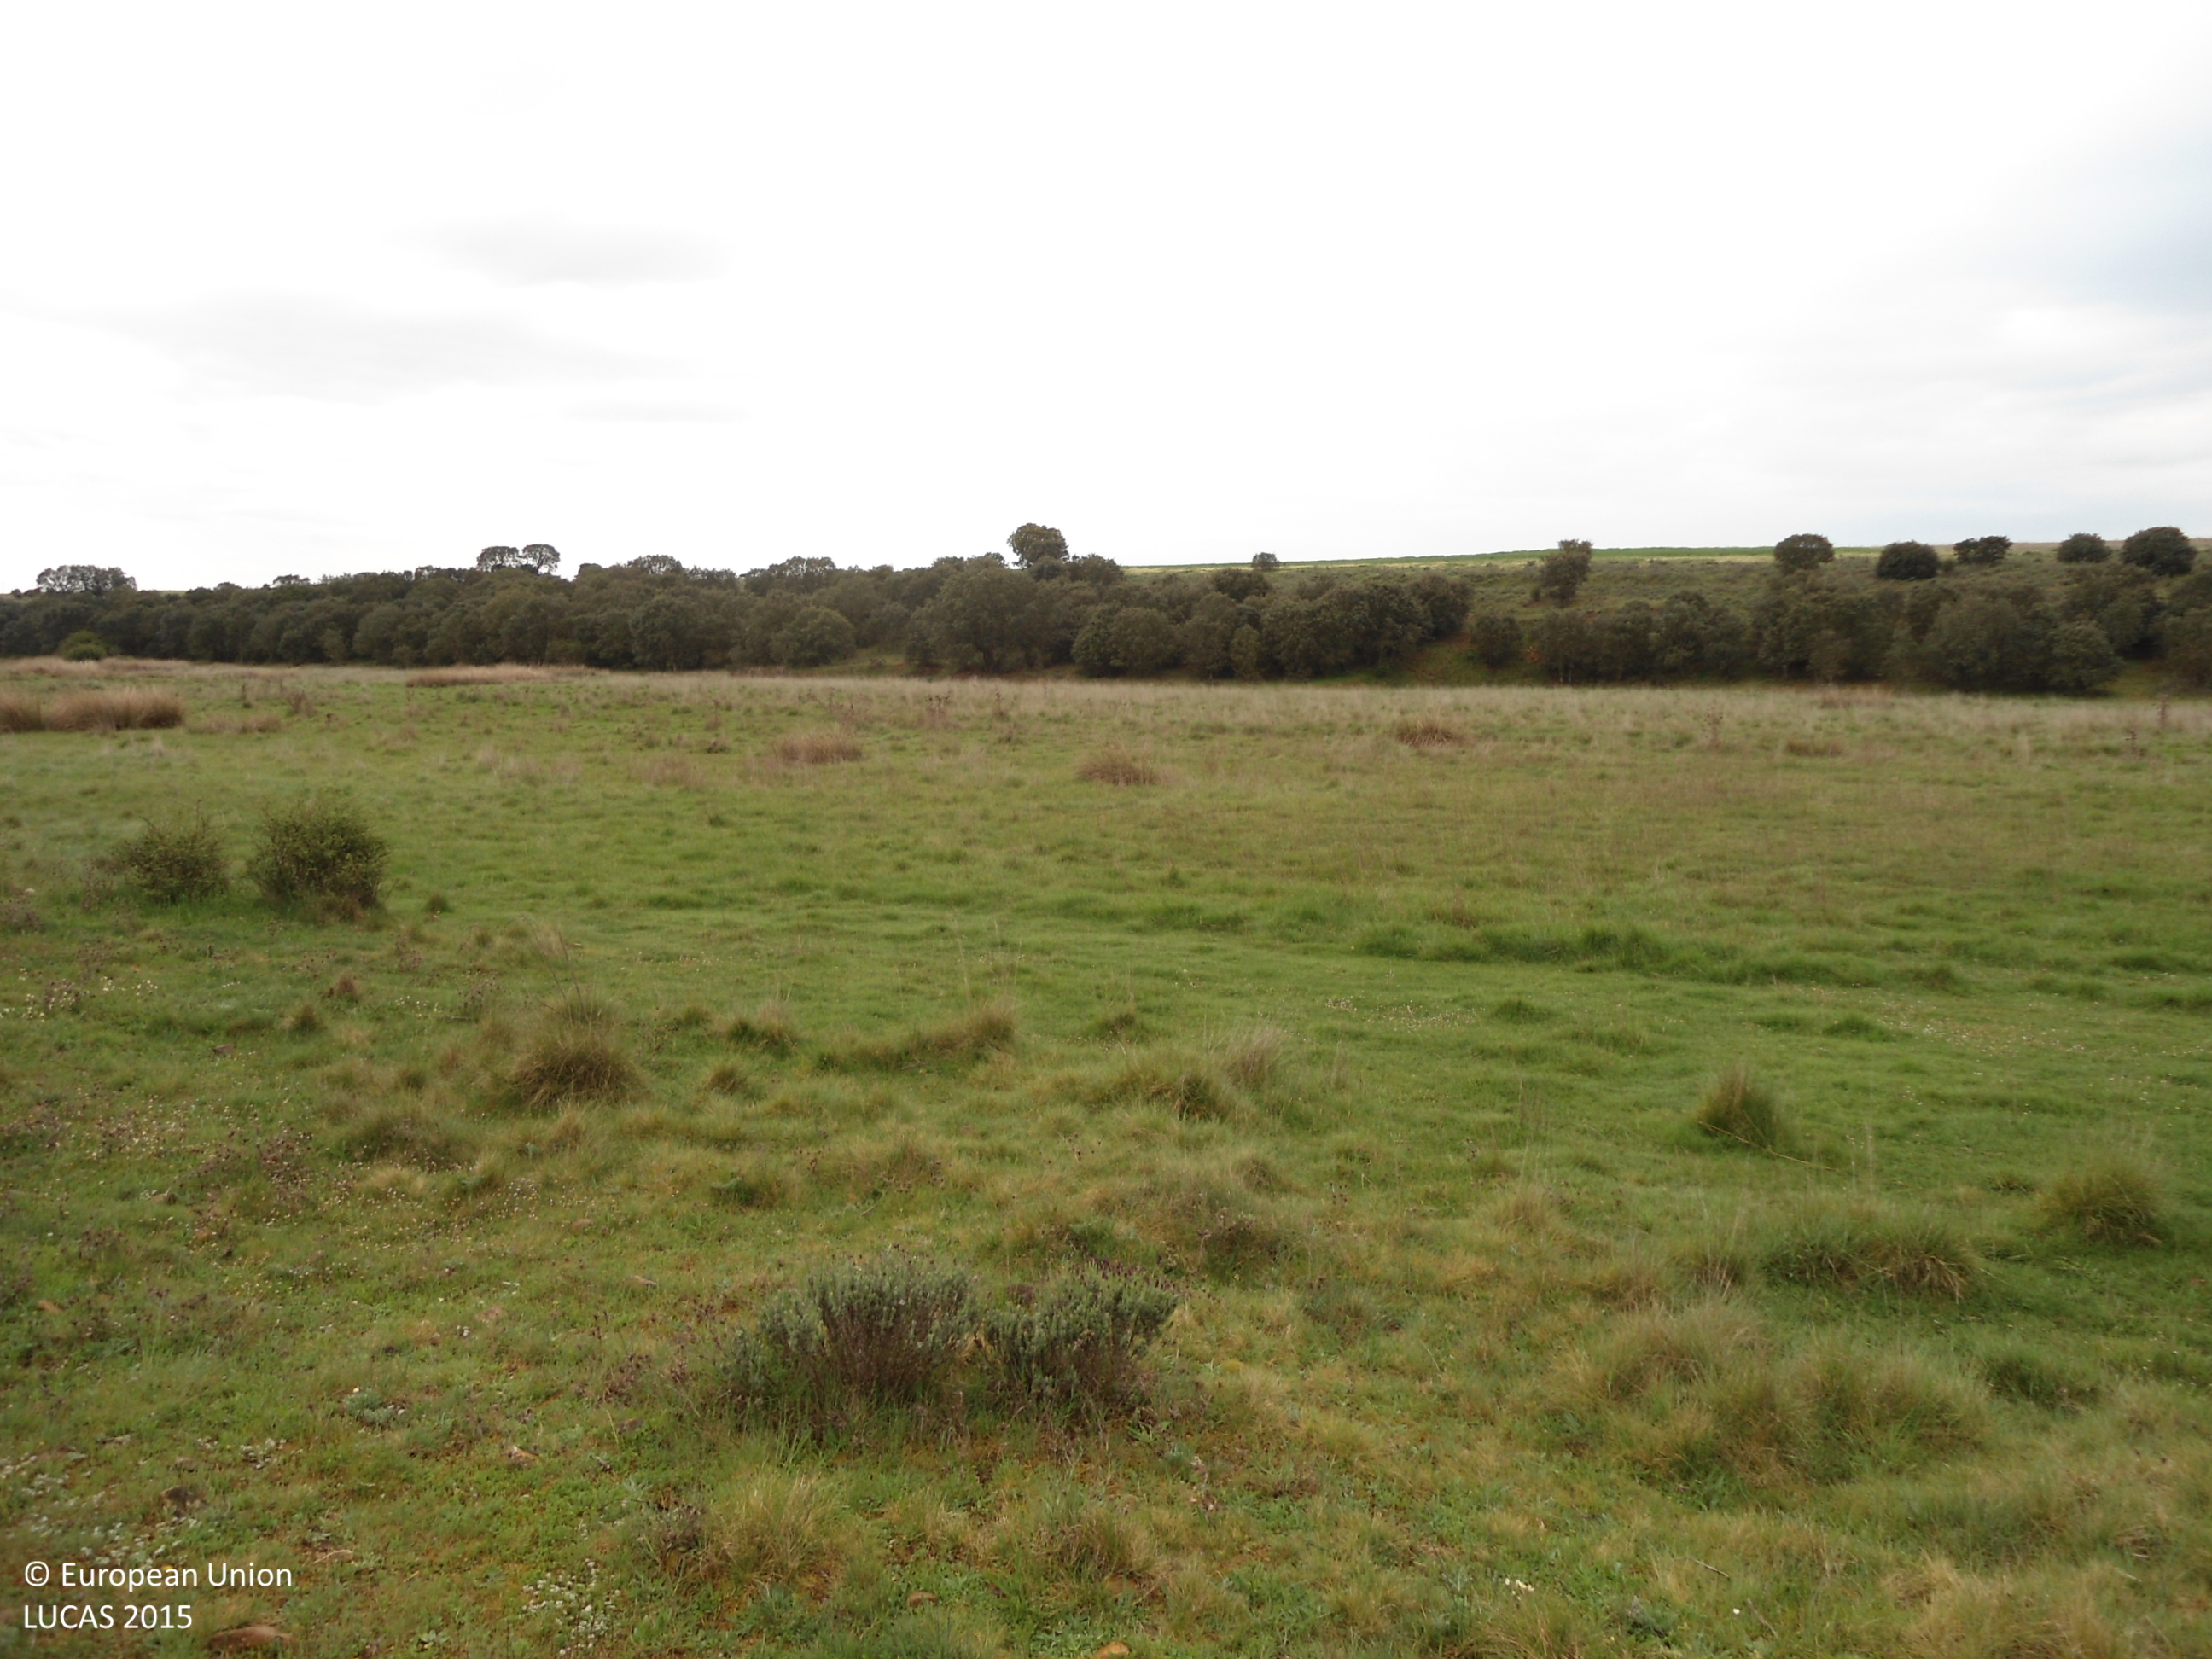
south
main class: Shrubland
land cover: Shrubland without tree cover
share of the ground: > 75 %
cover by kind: shrubs 80 %, herbaceous plants 20 %
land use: Agriculture (excluding fallow land and kitchen gardens)
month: April
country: ES
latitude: 41.7271
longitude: -5.8520
